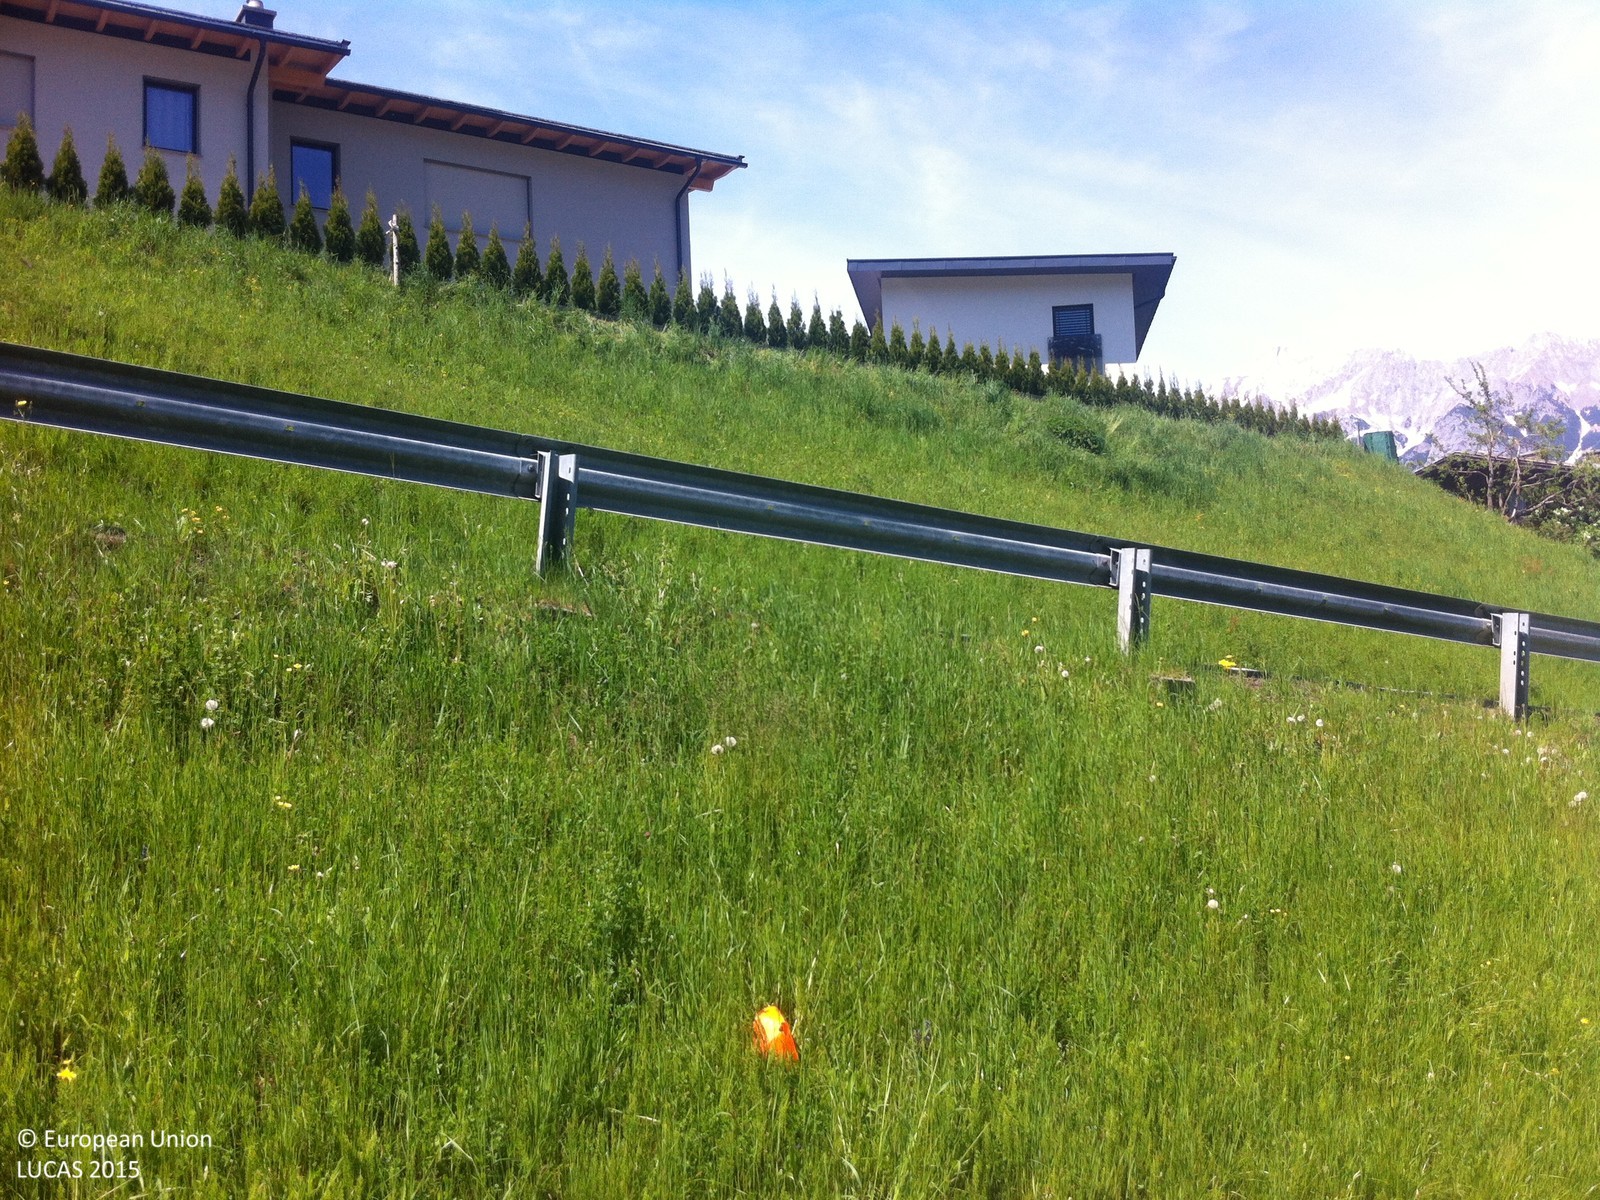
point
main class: Grassland
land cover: Grassland without tree/shrub cover
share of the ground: > 75 %
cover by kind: herbaceous plants 100 %
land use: Agriculture (excluding fallow land and kitchen gardens)
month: May
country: AT
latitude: 47.3106
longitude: 11.6785
